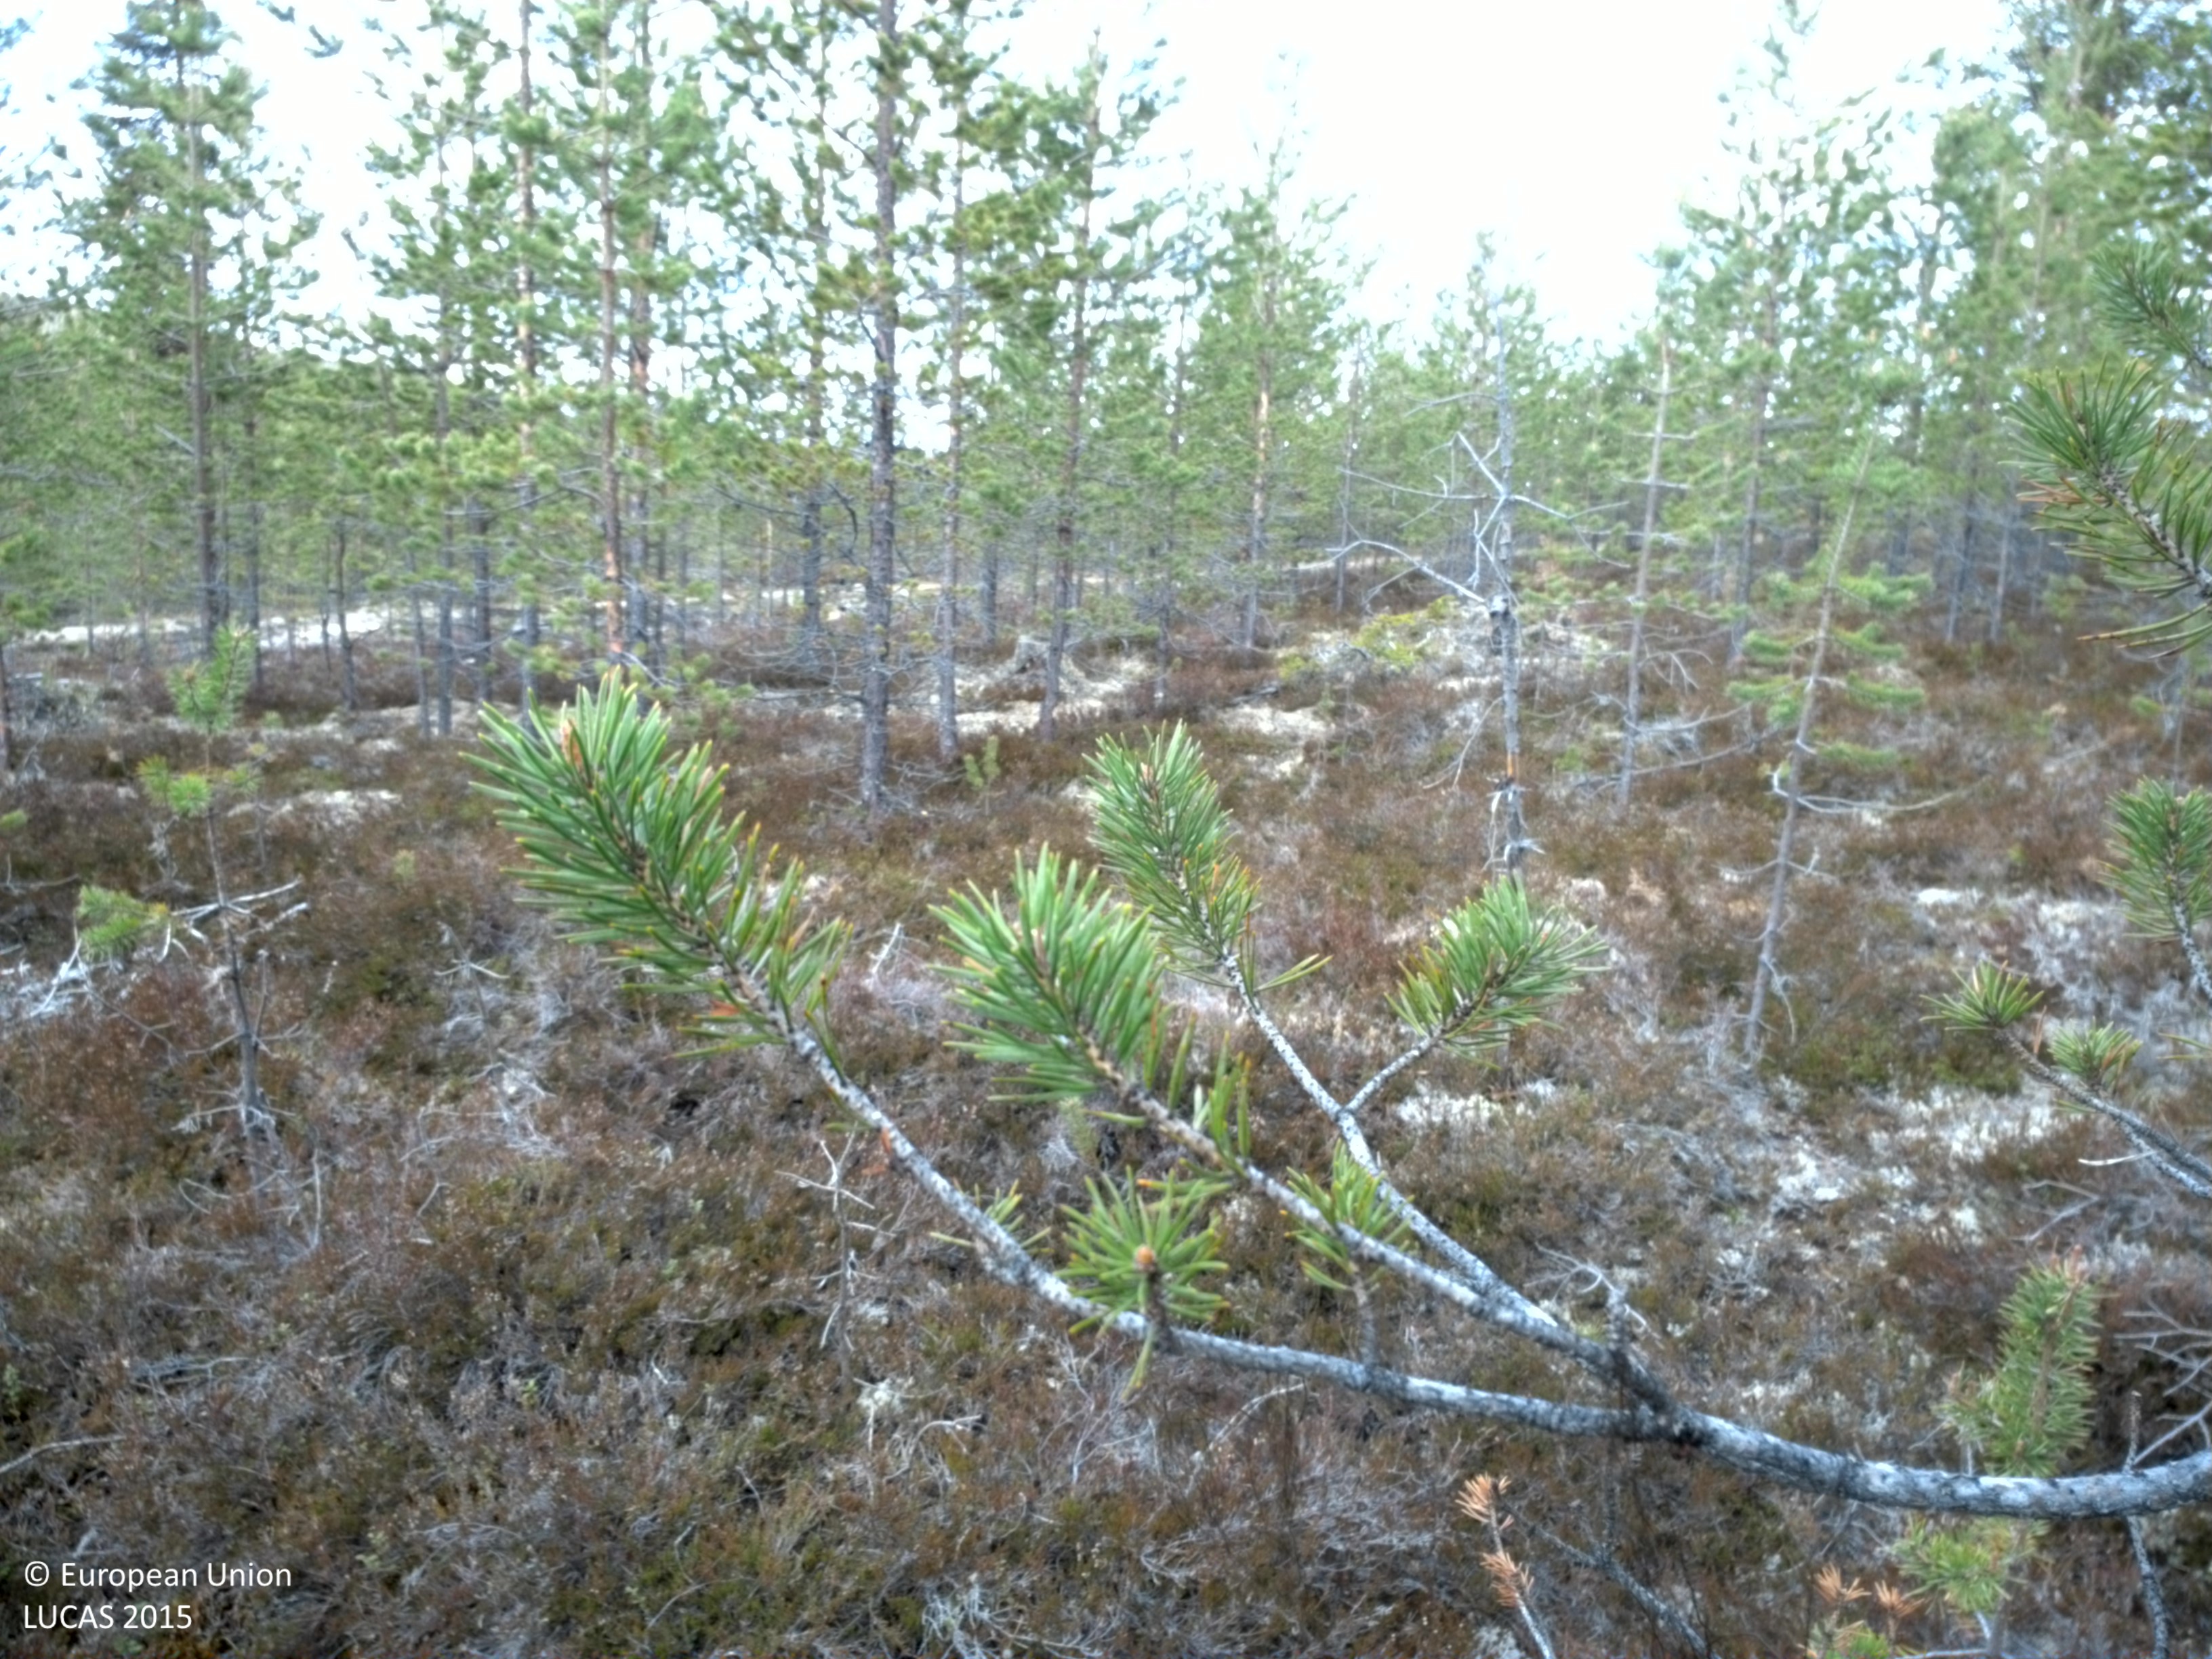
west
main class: Woodland
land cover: Pine dominated coniferous woodland
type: boreal forest
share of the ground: 25 - 50 %
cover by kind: shrubs 55 %, coniferous forest trees 35 %, lichens and mosses 10 %
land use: Forestry
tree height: < 5 m
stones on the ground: < 10 %
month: June
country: SE
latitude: 66.0970
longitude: 19.2230
